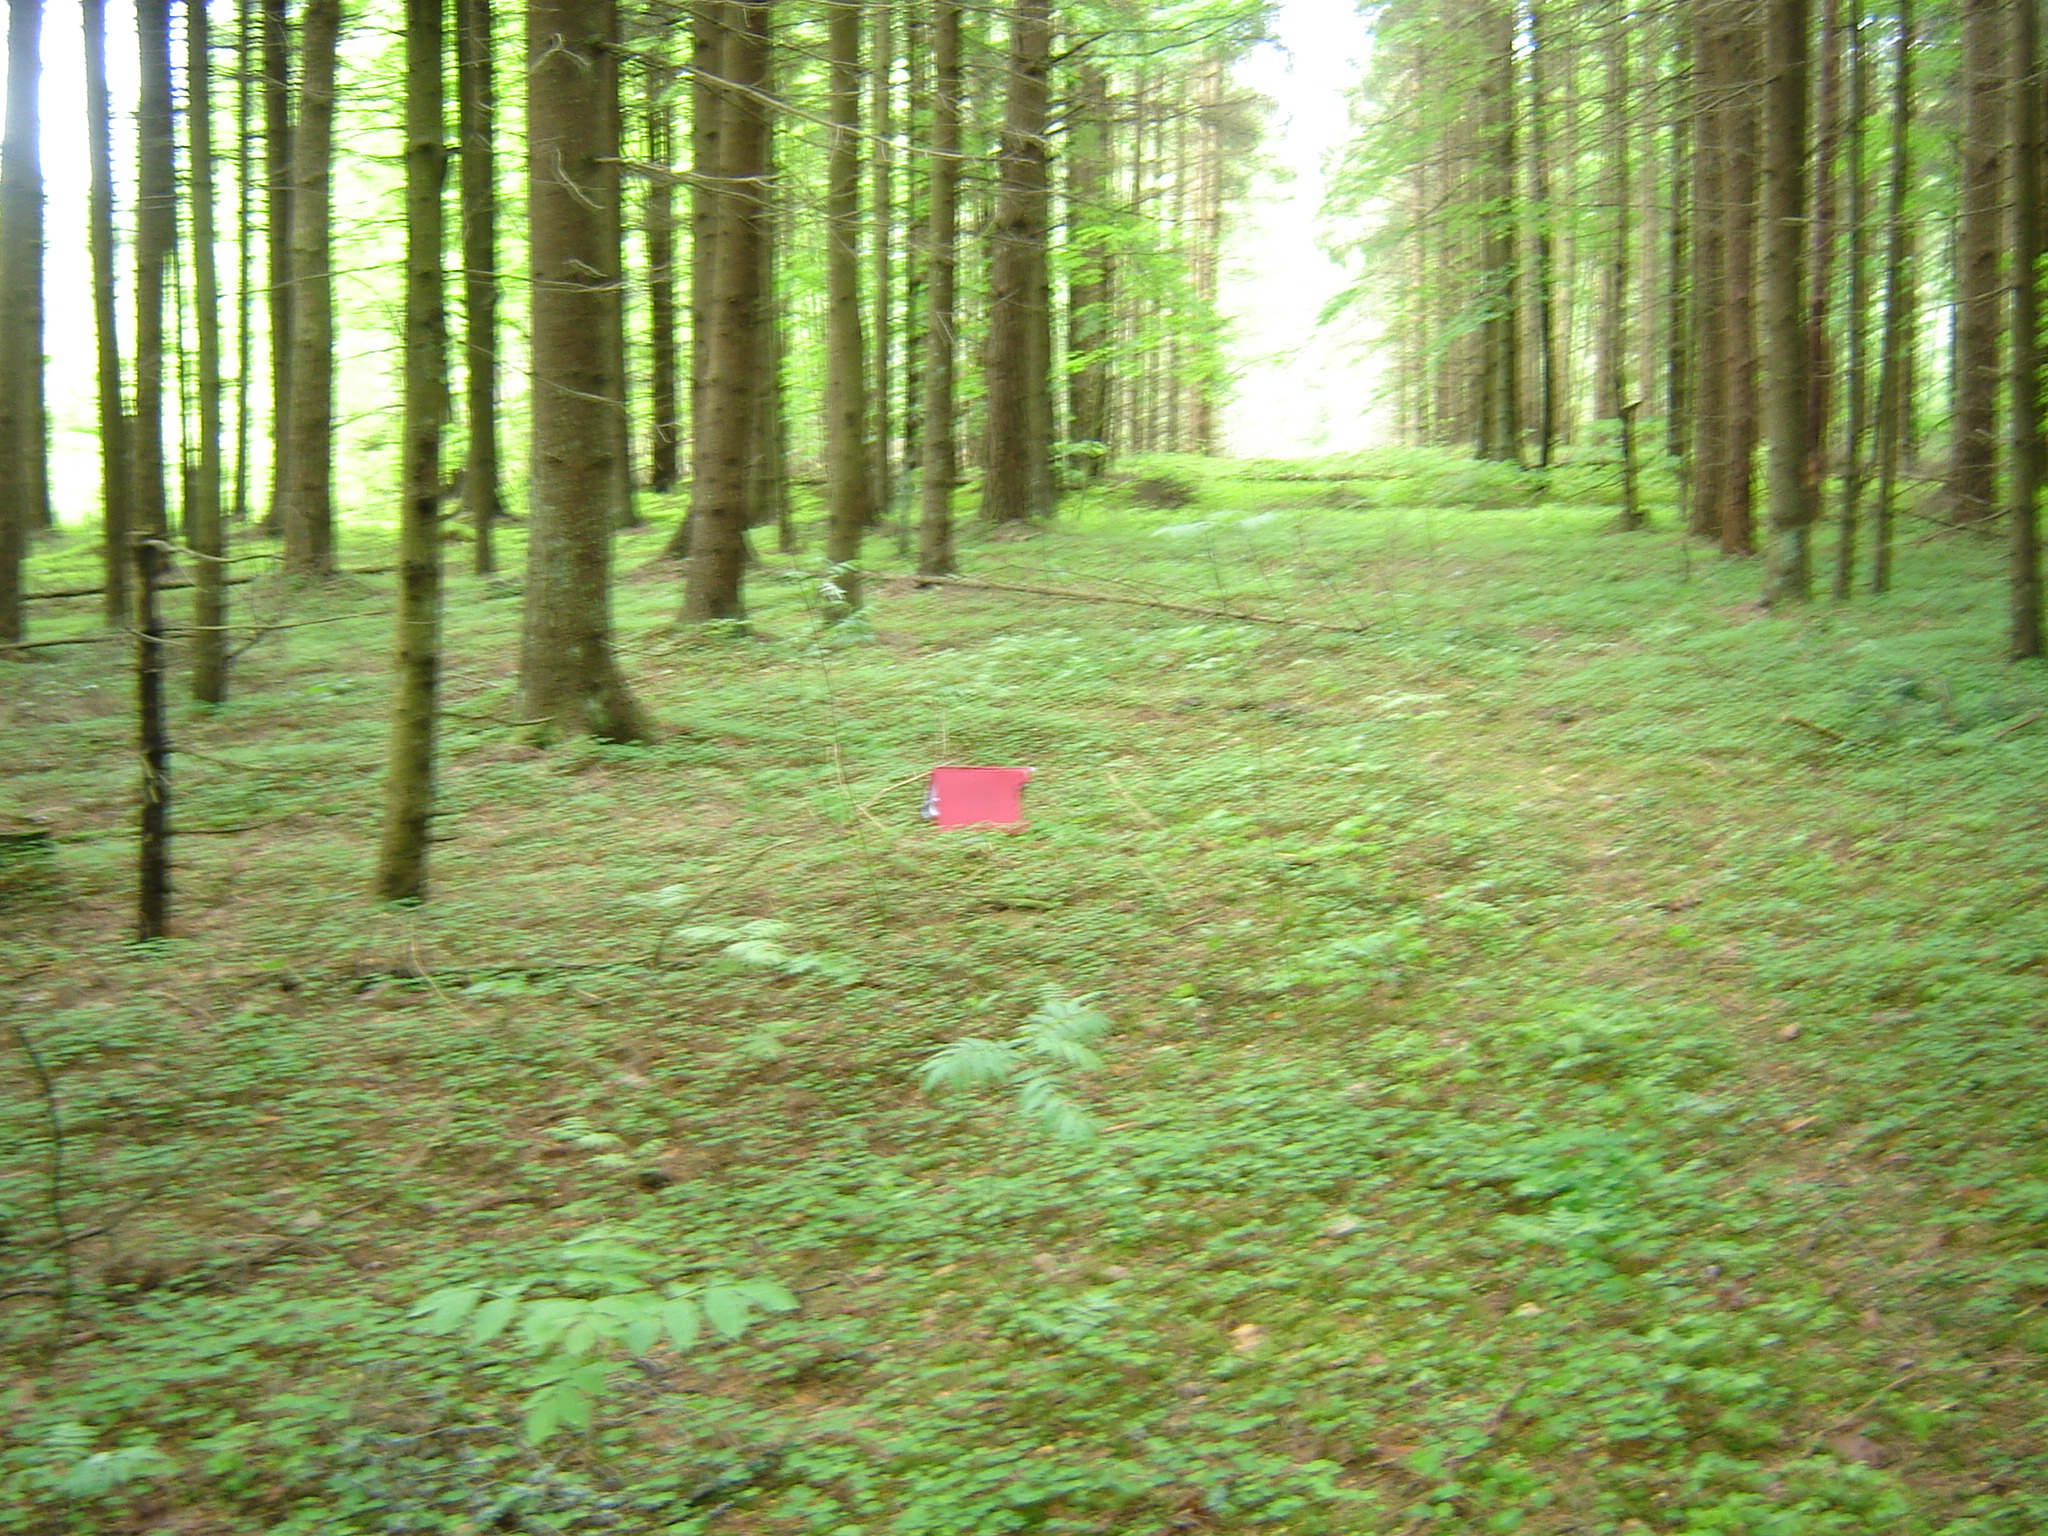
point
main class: Woodland
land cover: Other coniferous woodland
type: hemiboreal forest and nemoral coniferous forest and mixed broadleaved-coniferous forest
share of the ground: > 75 %
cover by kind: coniferous forest trees 80 %, herbaceous plants 15 %, broadleaved forest trees 5 %
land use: Forestry
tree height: > 5 m
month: May
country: LT
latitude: 55.9844
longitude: 25.3947
